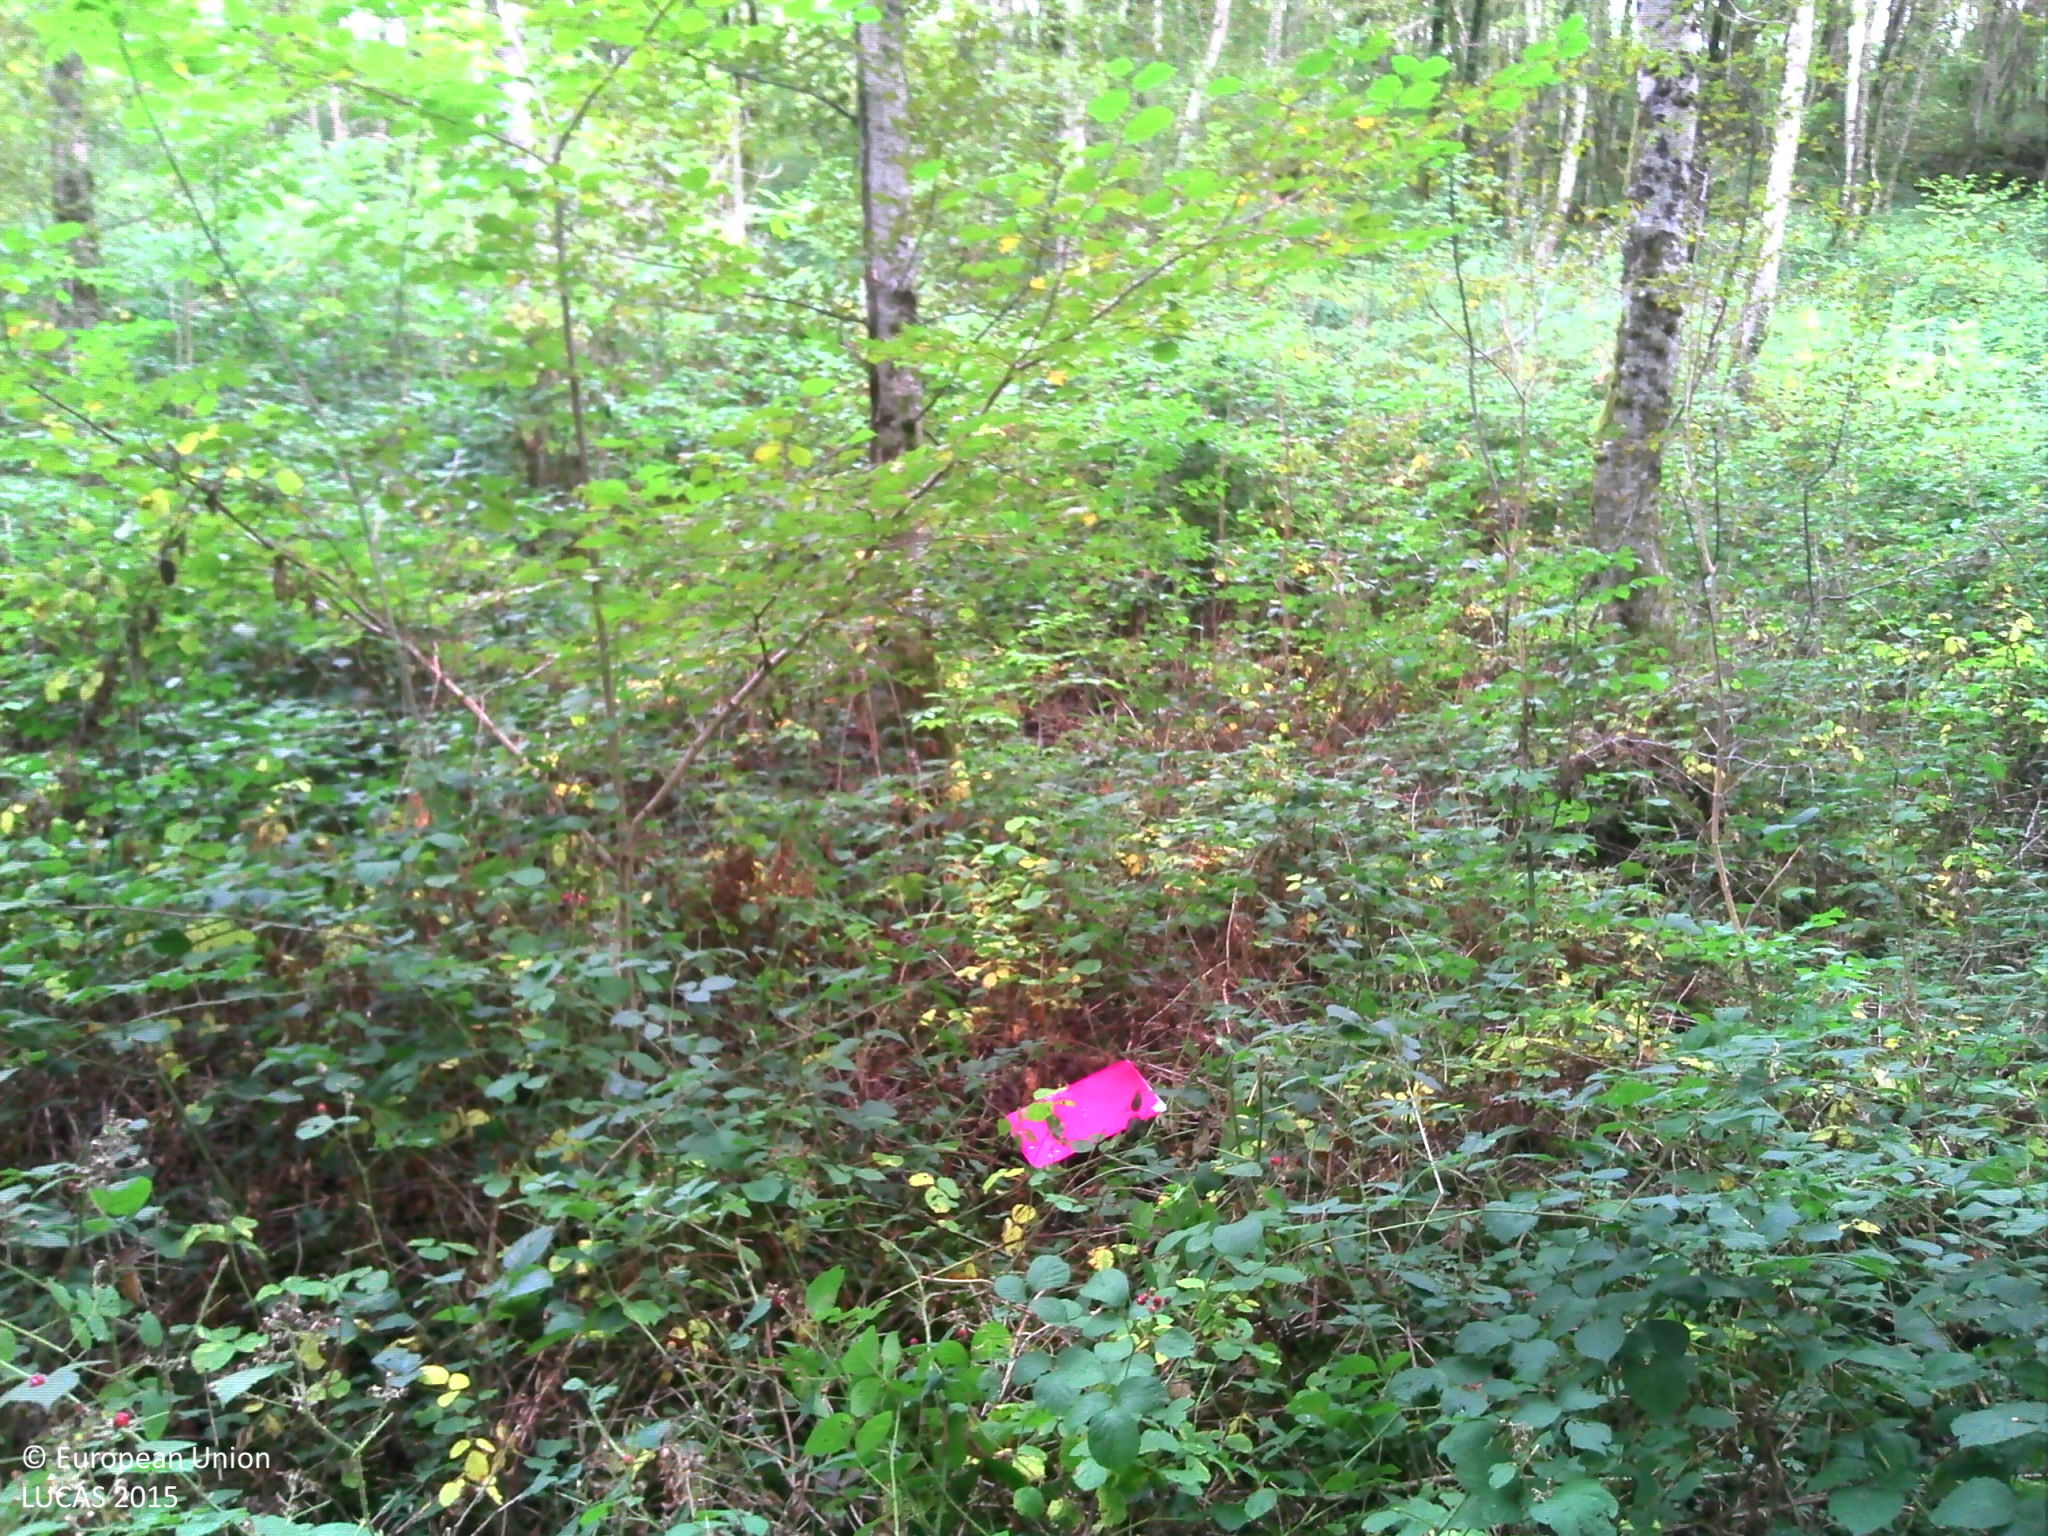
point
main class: Woodland
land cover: Broadleaved woodland
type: mesophytic deciduous forest
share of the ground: > 75 %
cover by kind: broadleaved forest trees 65 %, shrubs 25 %, herbaceous plants 10 %
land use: Forestry
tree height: > 5 m
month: September
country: FR
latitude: 47.3382
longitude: 4.6927
